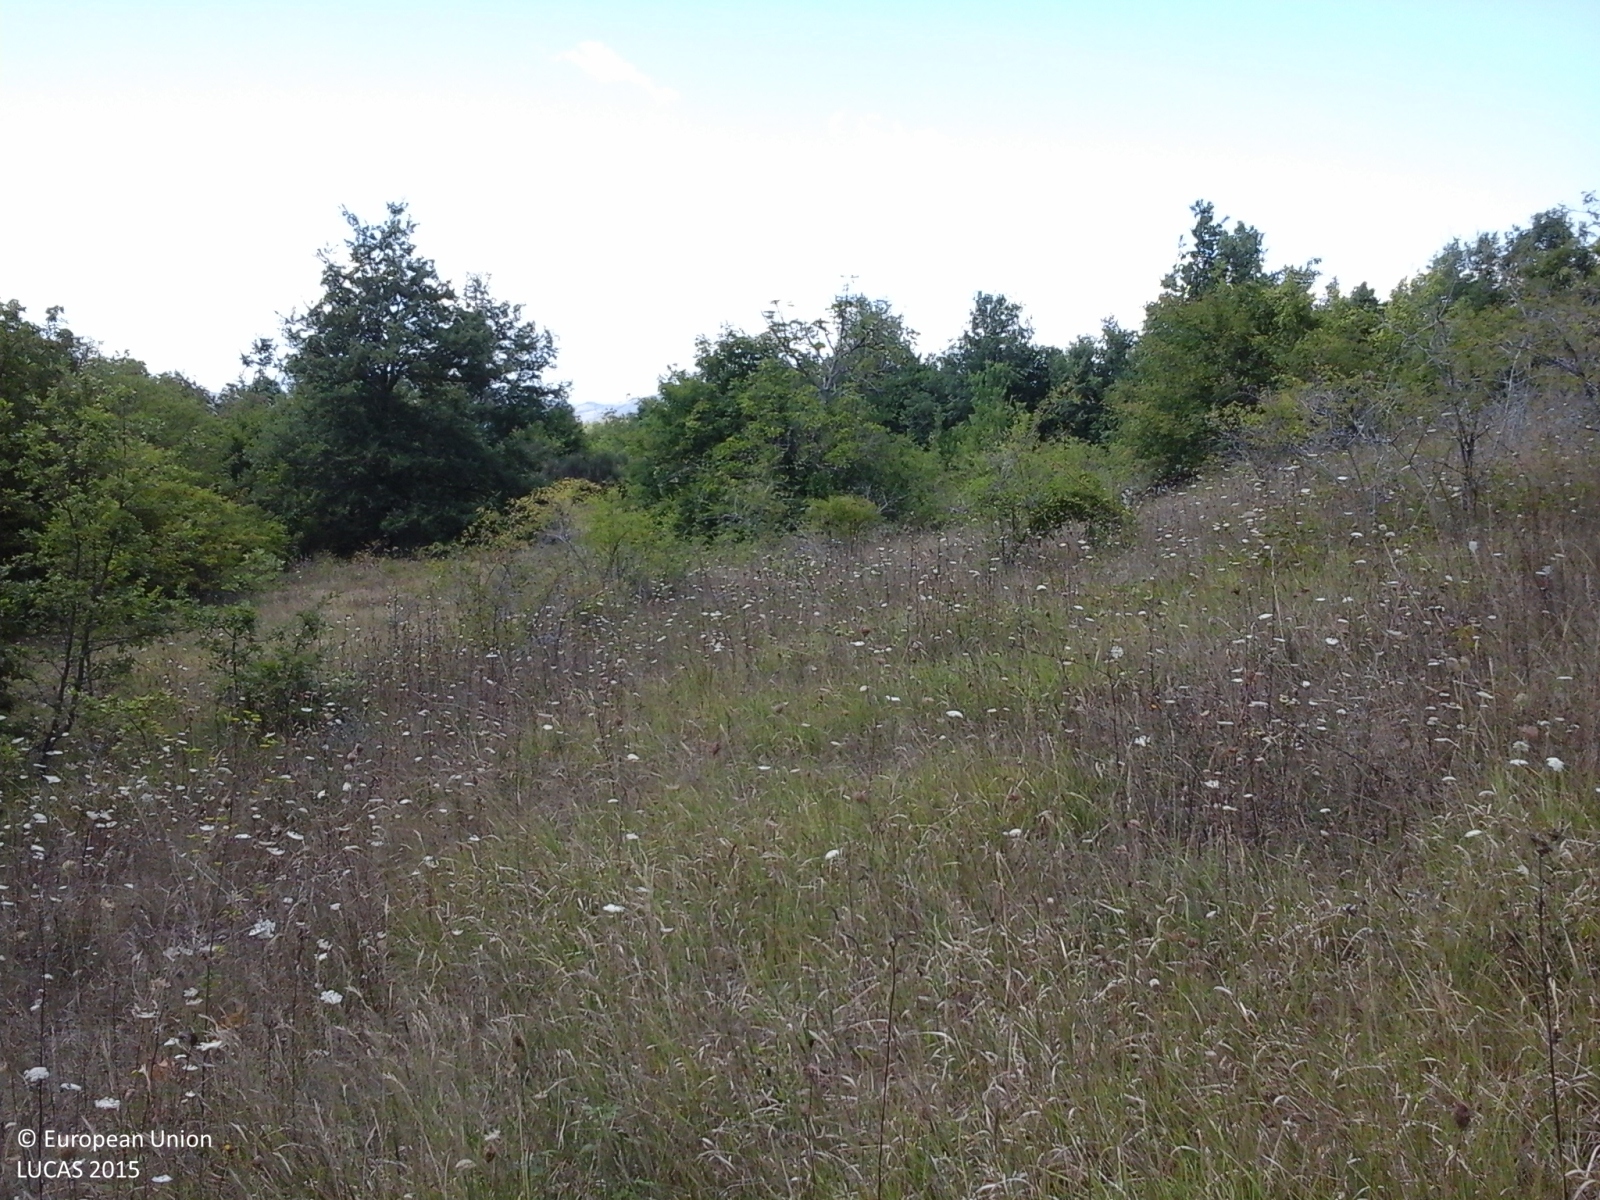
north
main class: Woodland
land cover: Broadleaved woodland
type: thermophilous deciduous forest
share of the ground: > 75 %
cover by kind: broadleaved forest trees 75 %, shrubs 20 %, herbaceous plants 5 %
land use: Semi-natural and natural areas not in use
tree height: > 5 m
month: August
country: IT
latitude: 41.5831
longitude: 14.3626
